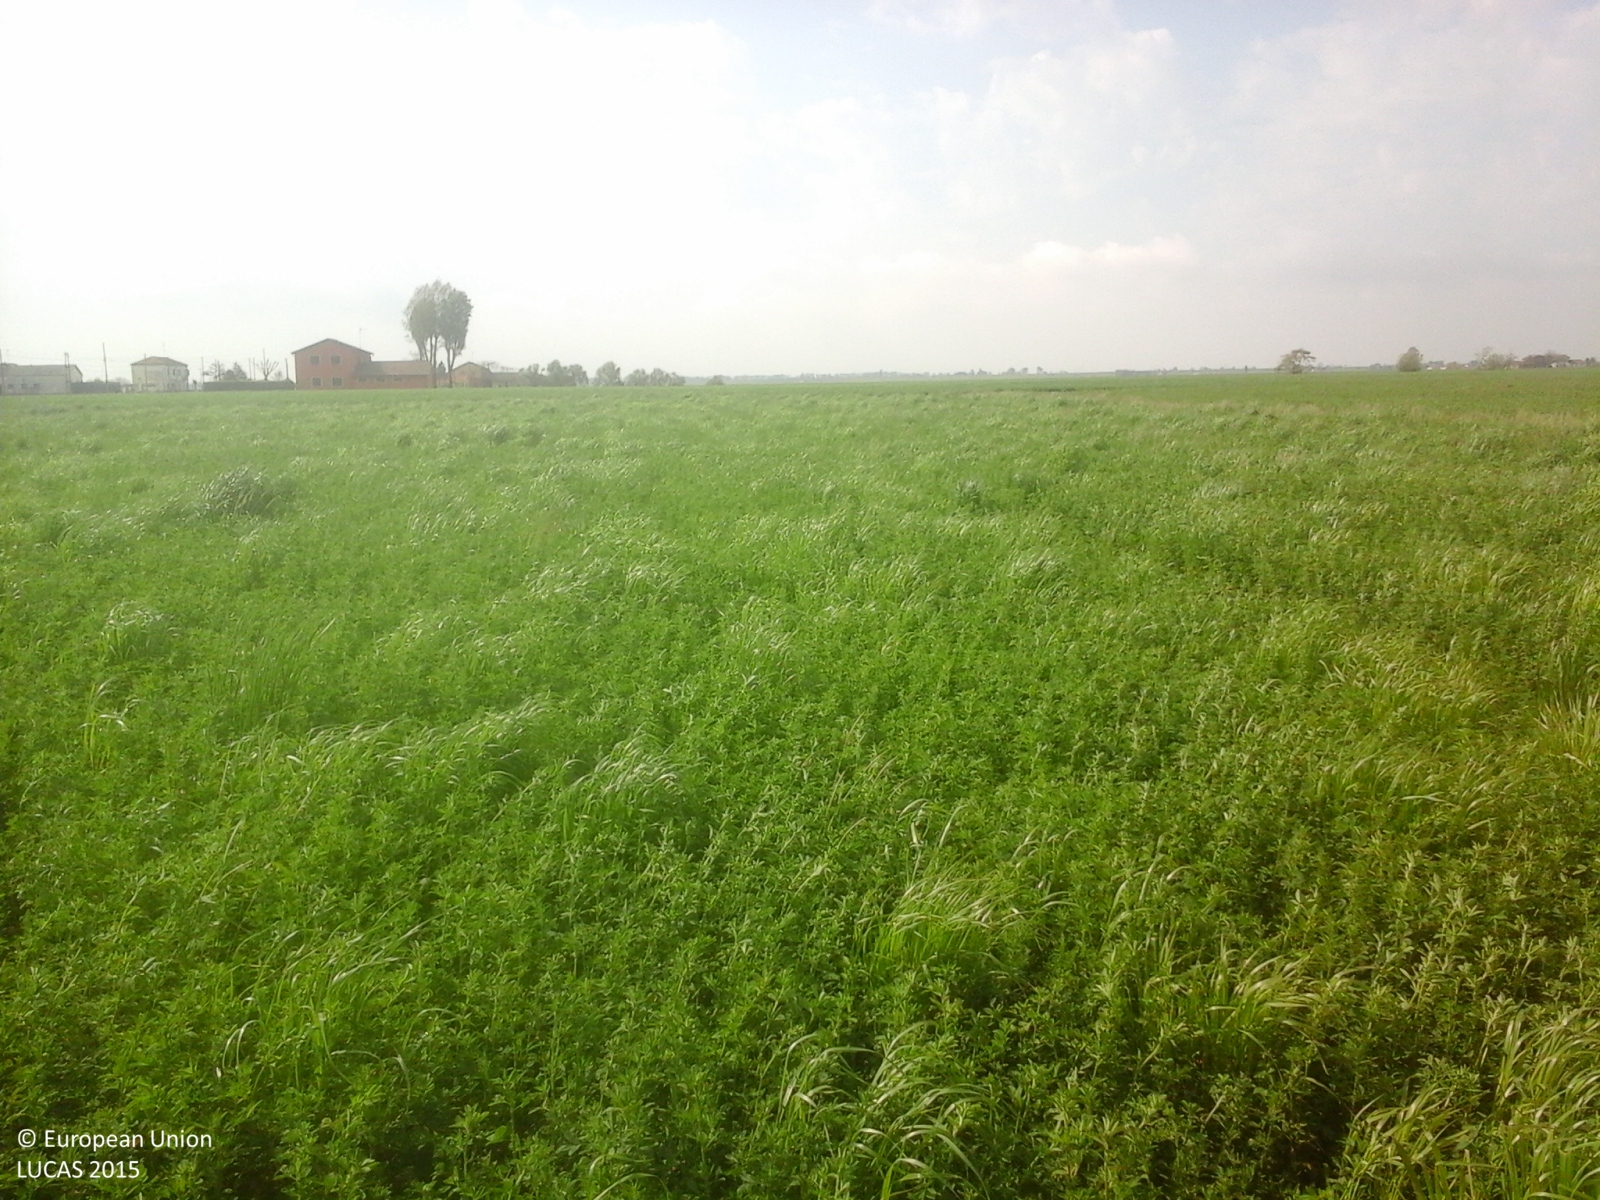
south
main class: Cropland
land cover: Lucerne
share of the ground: > 75 %
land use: Agriculture (excluding fallow land and kitchen gardens)
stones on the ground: < 10 %
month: April
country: IT
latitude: 44.9899
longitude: 12.4183
